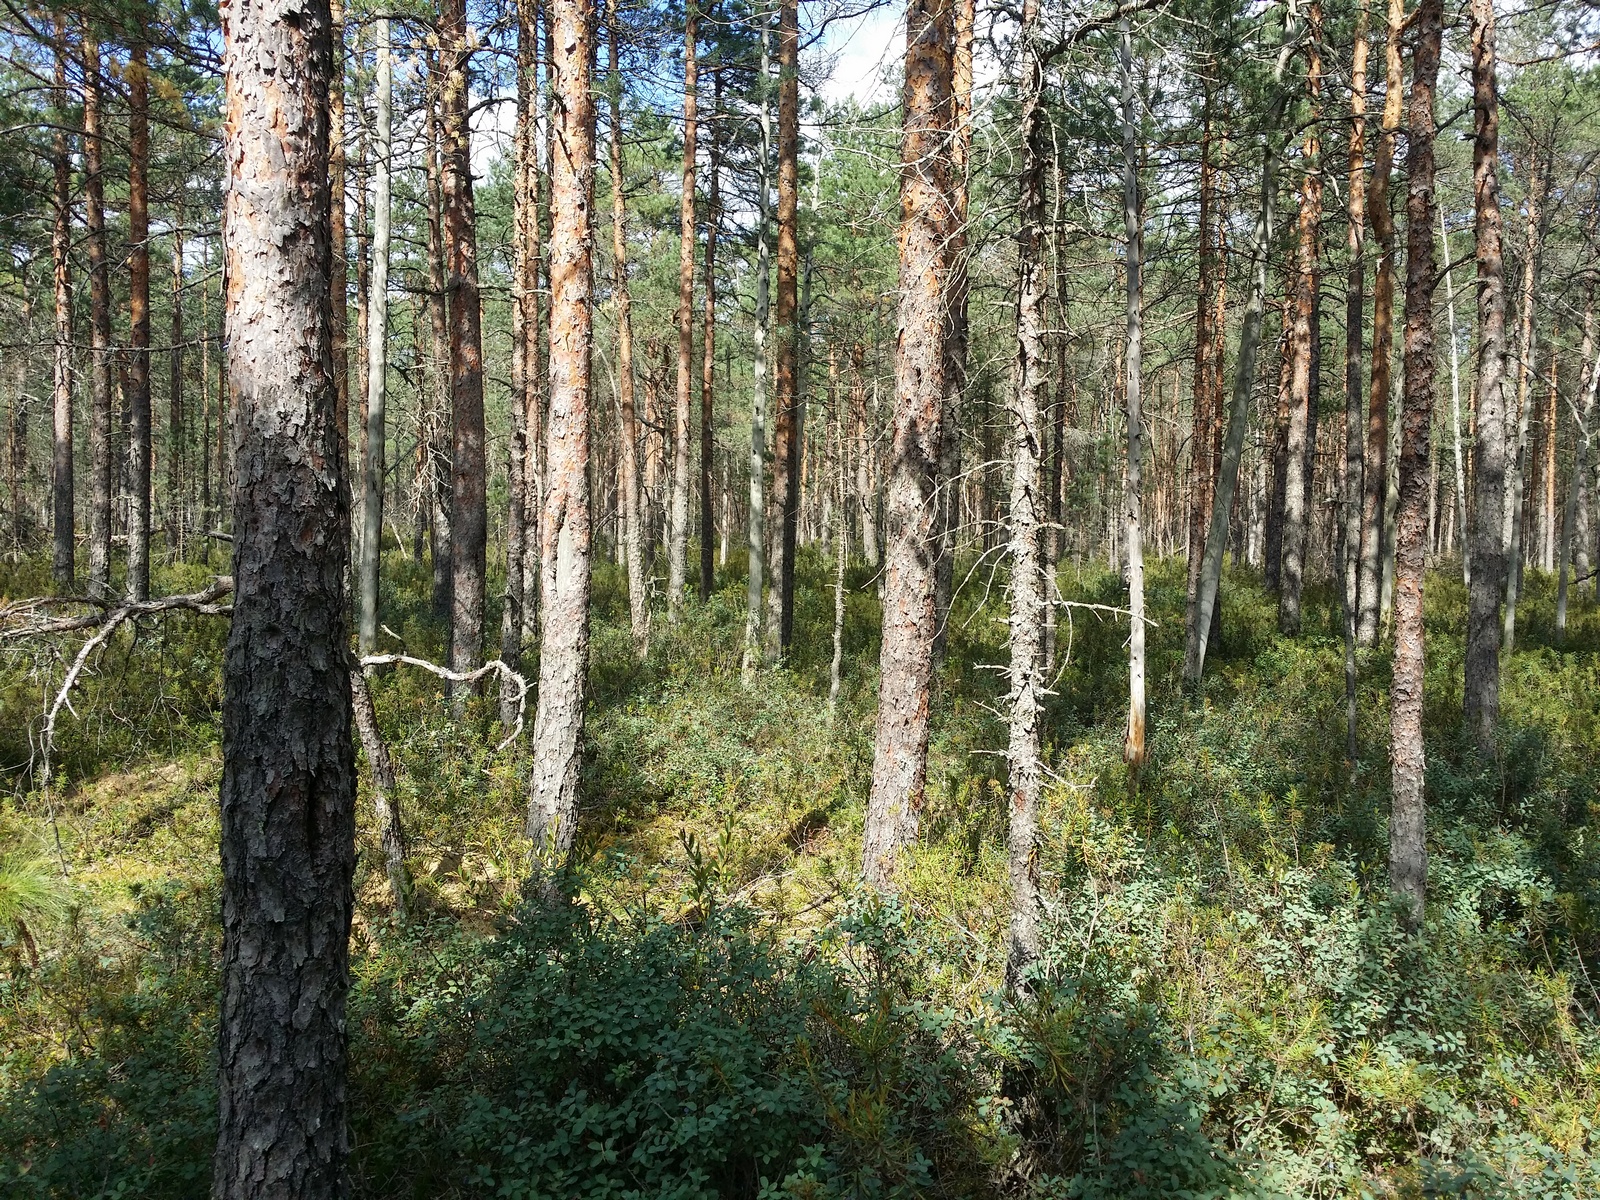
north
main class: Woodland
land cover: Pine dominated coniferous woodland
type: hemiboreal forest and nemoral coniferous forest and mixed broadleaved-coniferous forest
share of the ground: 50 - 75 %
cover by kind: coniferous forest trees 70 %, shrubs 20 %, herbaceous plants 10 %
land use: Semi-natural and natural areas not in use
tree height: > 5 m
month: August
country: LV
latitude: 57.0257
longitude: 27.4564
